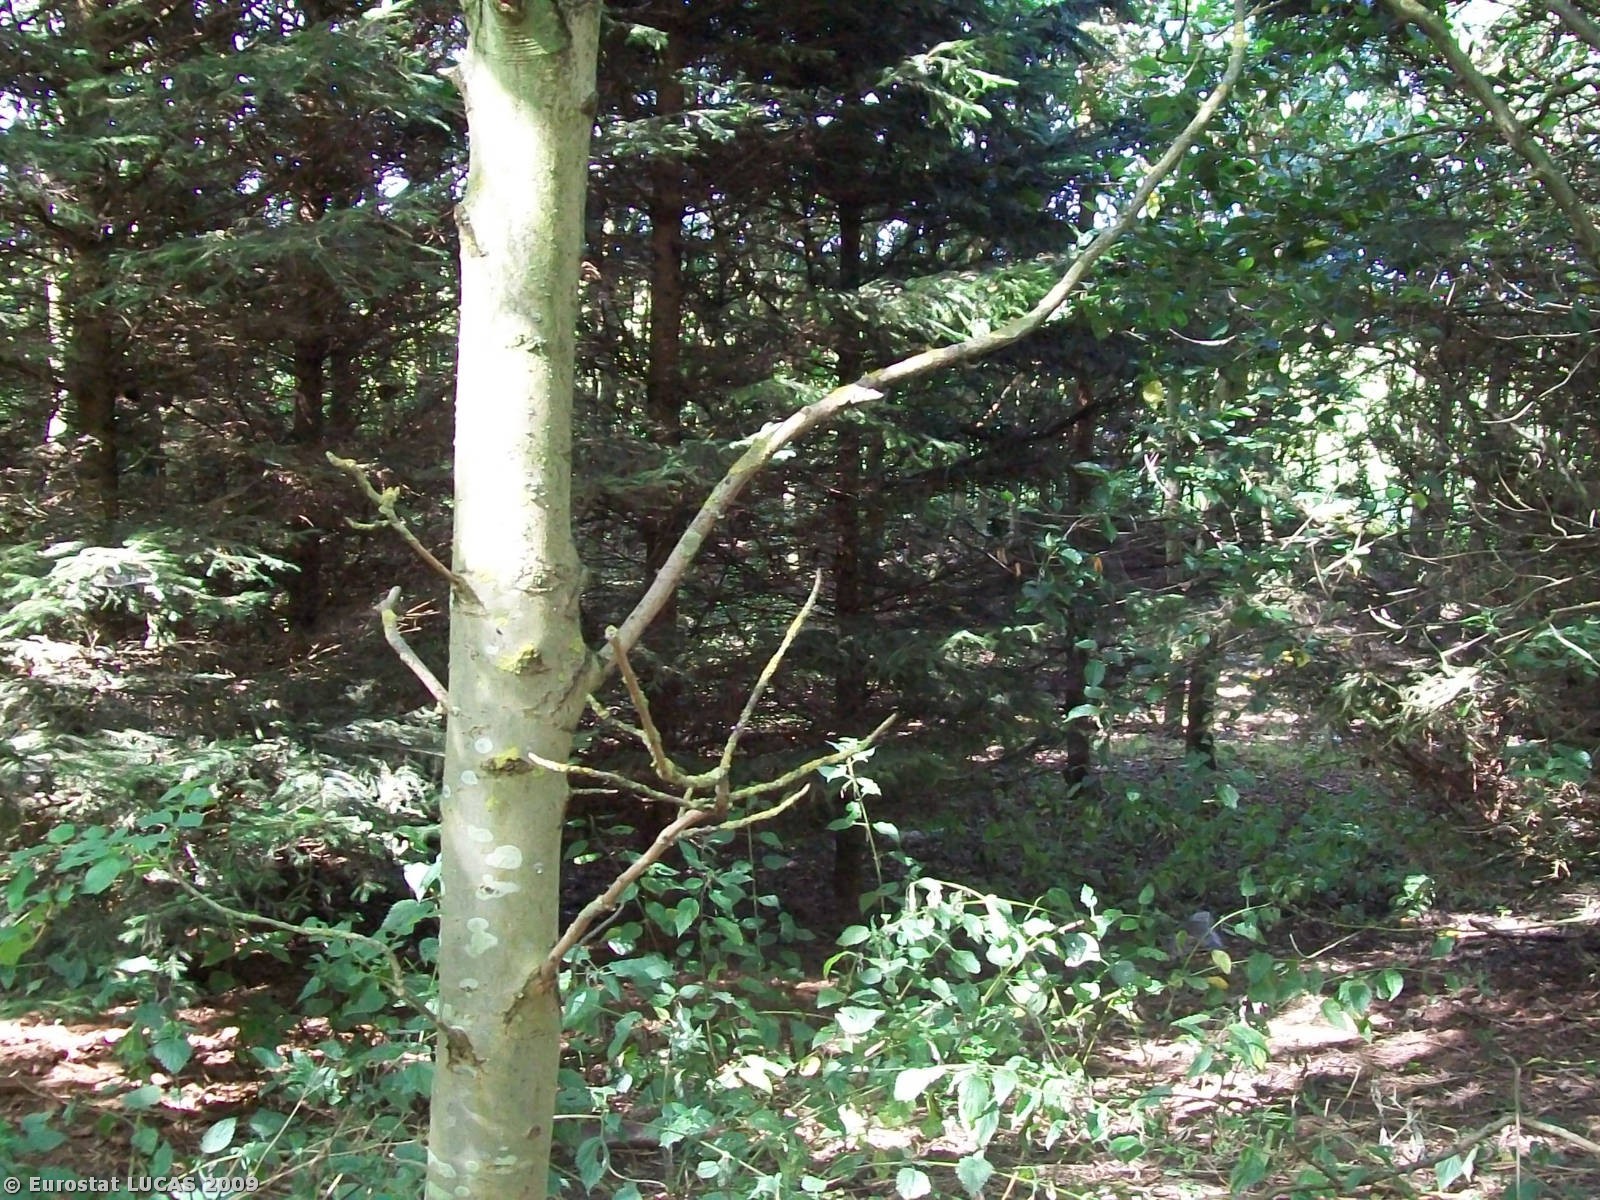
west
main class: Woodland
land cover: Broadleaved woodland
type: mesophytic deciduous forest
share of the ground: > 75 %
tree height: > 5 m
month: August
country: GB
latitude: 52.4927
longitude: -1.0767
